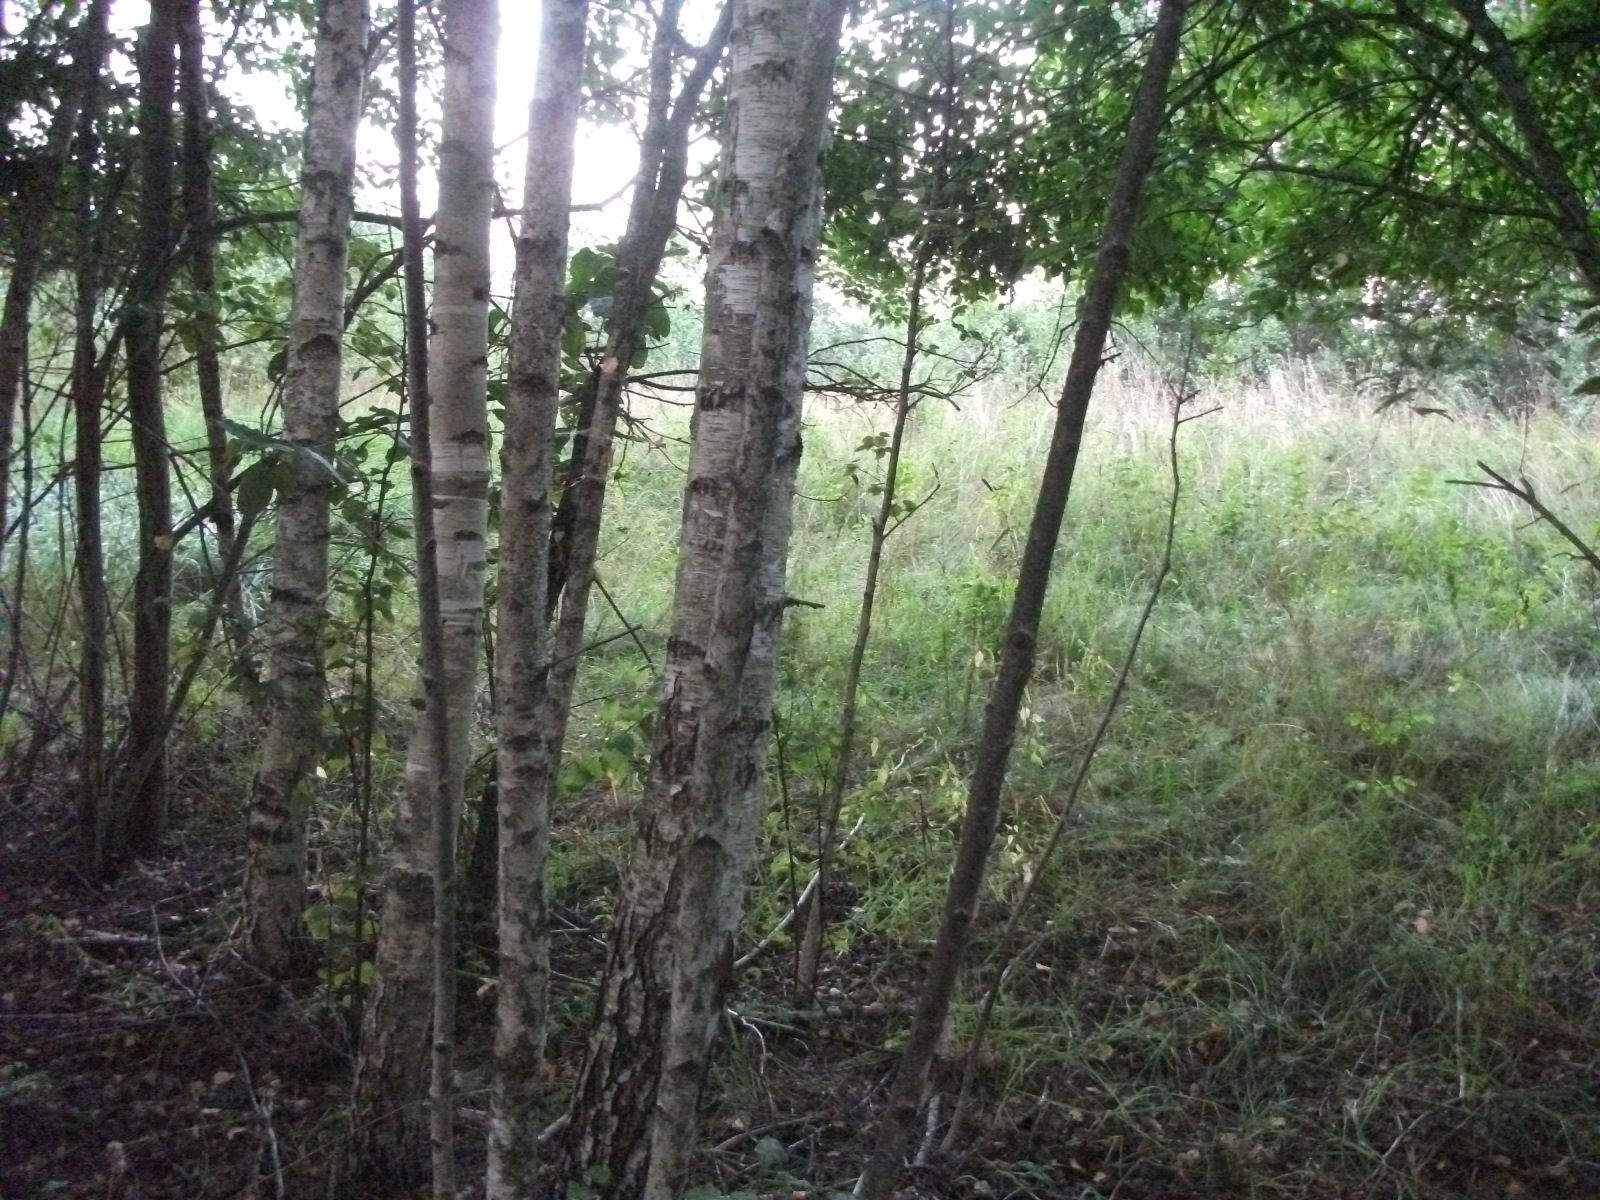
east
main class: Woodland
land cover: Broadleaved woodland
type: non-riverine alder, birch or aspen forest
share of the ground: > 75 %
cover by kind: broadleaved forest trees 80 %, unconsolidated bare surface 10 %, herbaceous plants 5 %
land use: Forestry
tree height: > 5 m
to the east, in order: Broadleaved woodland; Spontaneously vegetated surfaces; Grassland with sparse tree/shrub cover; Broadleaved woodland; Common wheat; Electric lines; Common wheat; Grass margins; Tracks; Grass margins; Common wheat
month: August
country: LV
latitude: 56.7662
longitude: 26.4901
